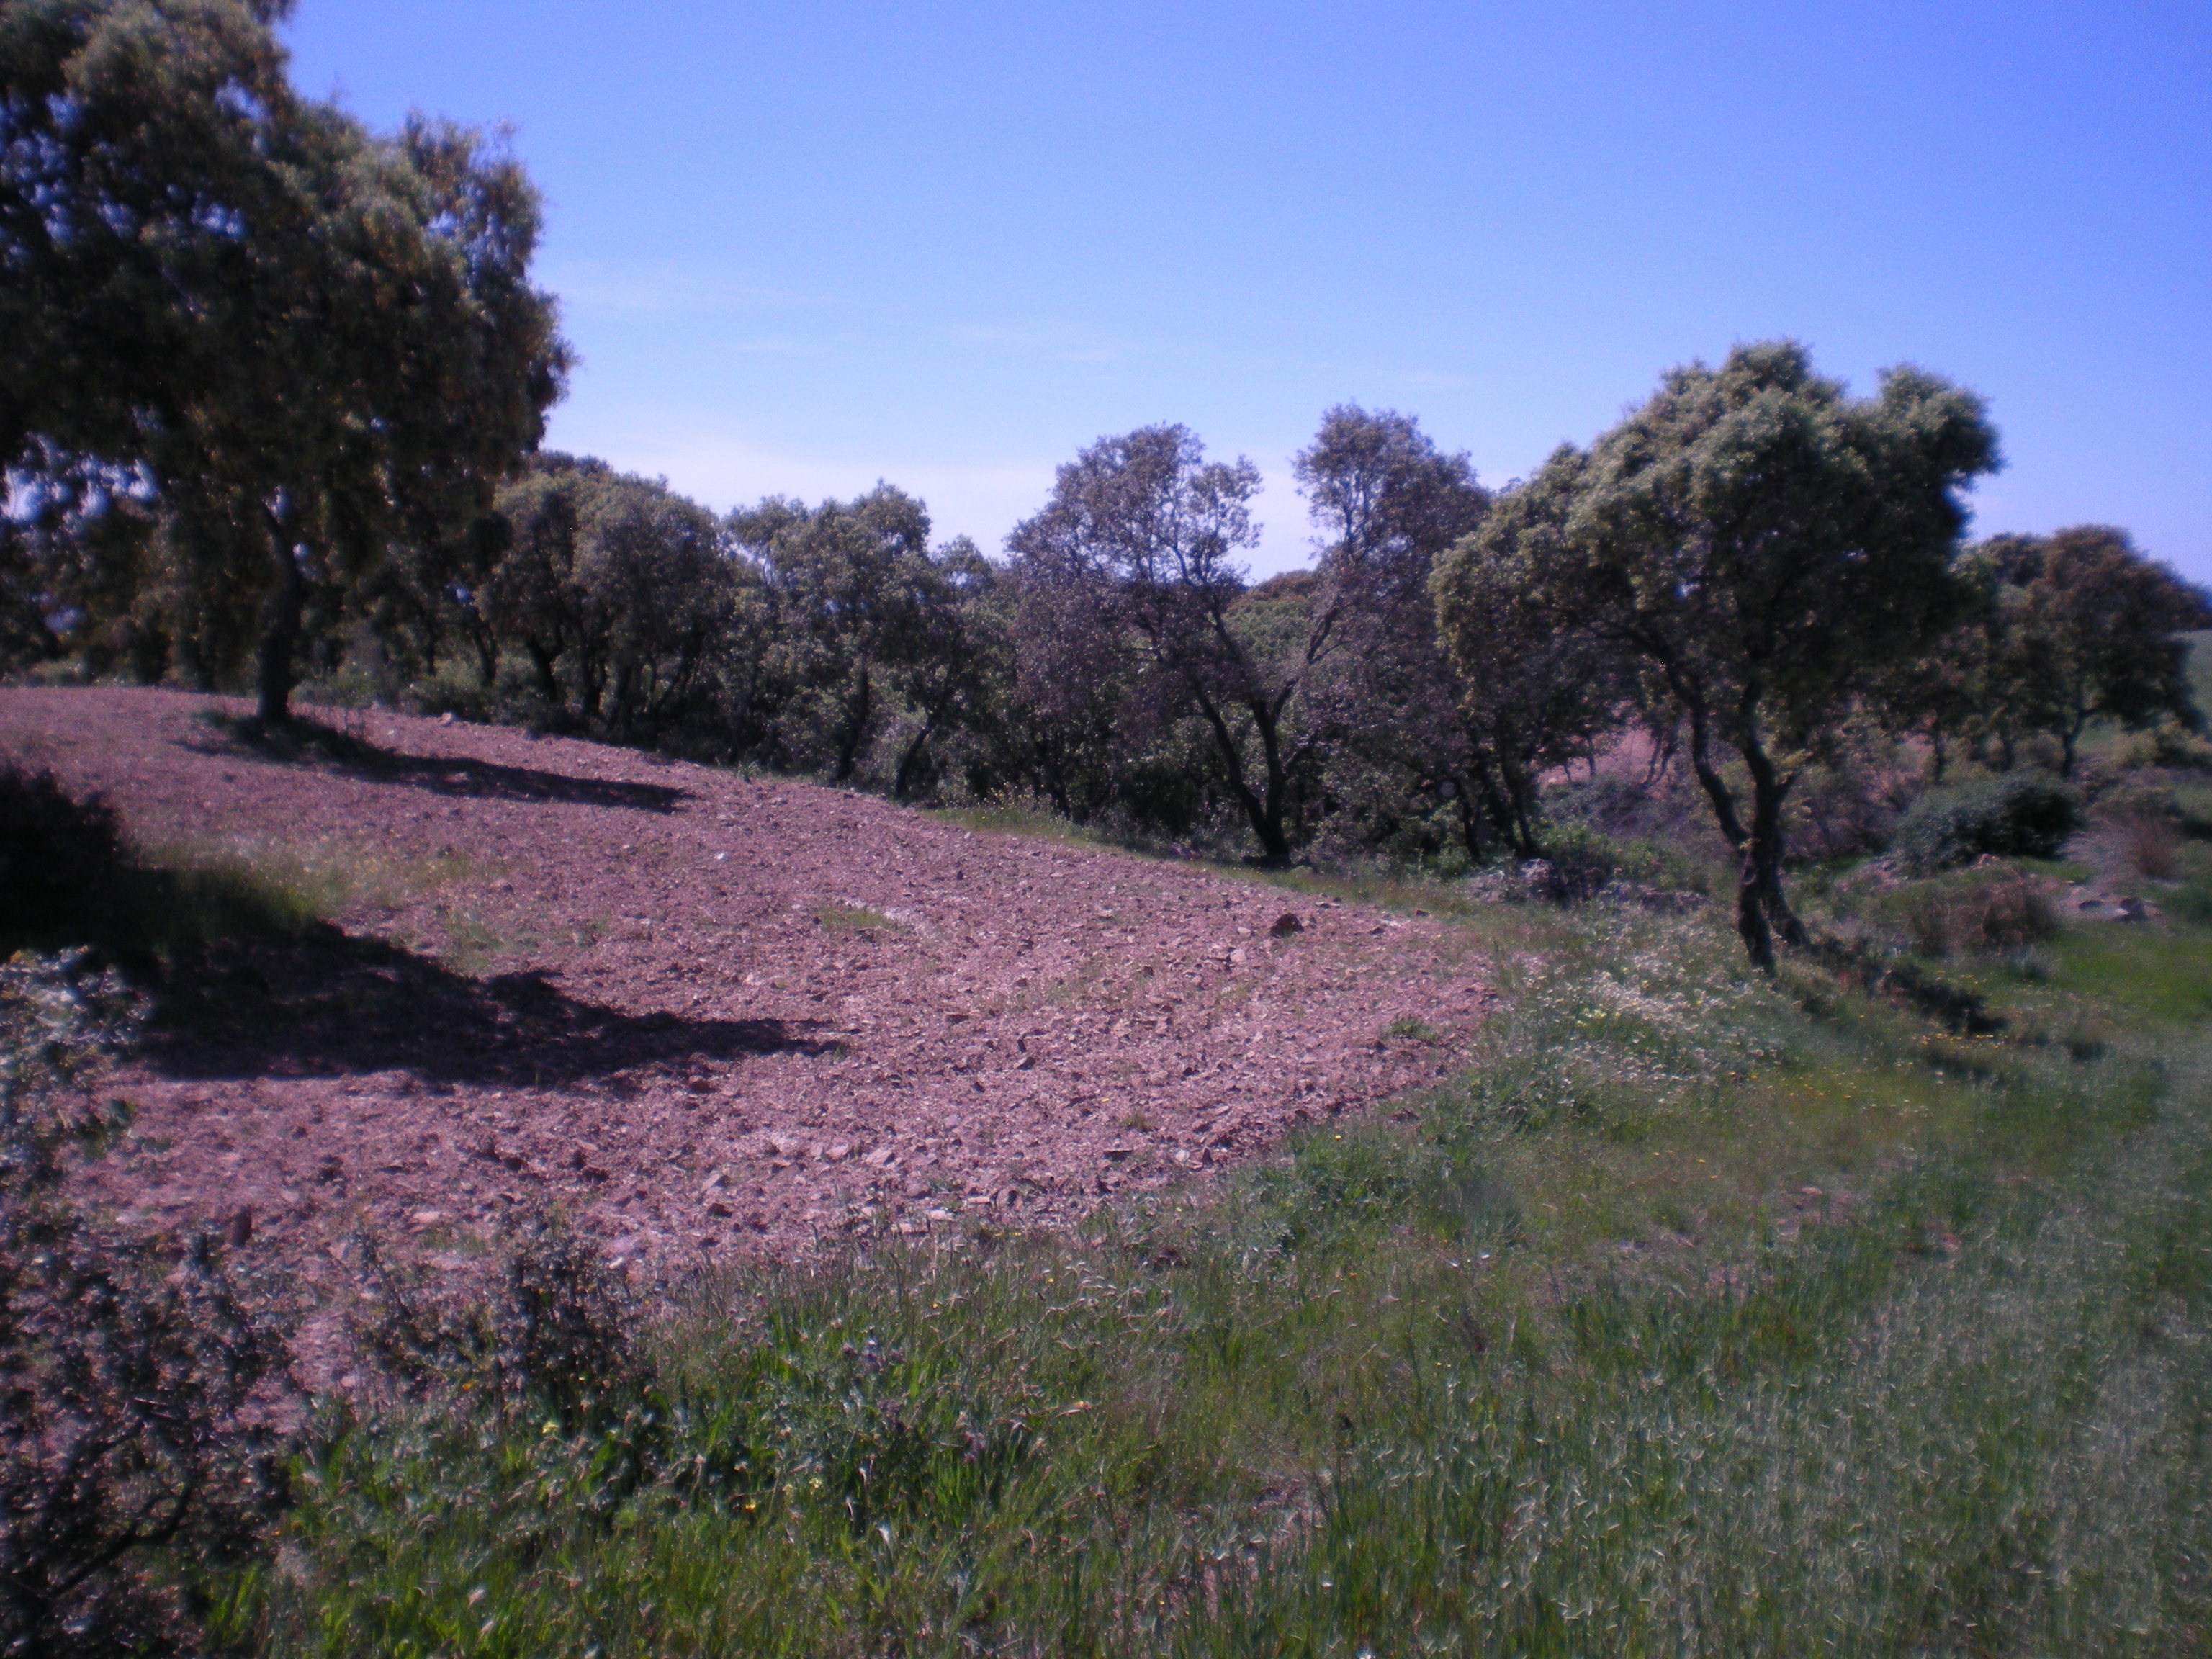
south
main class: Cropland
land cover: Oats
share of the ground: > 75 %
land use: Agriculture (excluding fallow land and kitchen gardens)
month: April
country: ES
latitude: 38.5079
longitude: -2.9500
